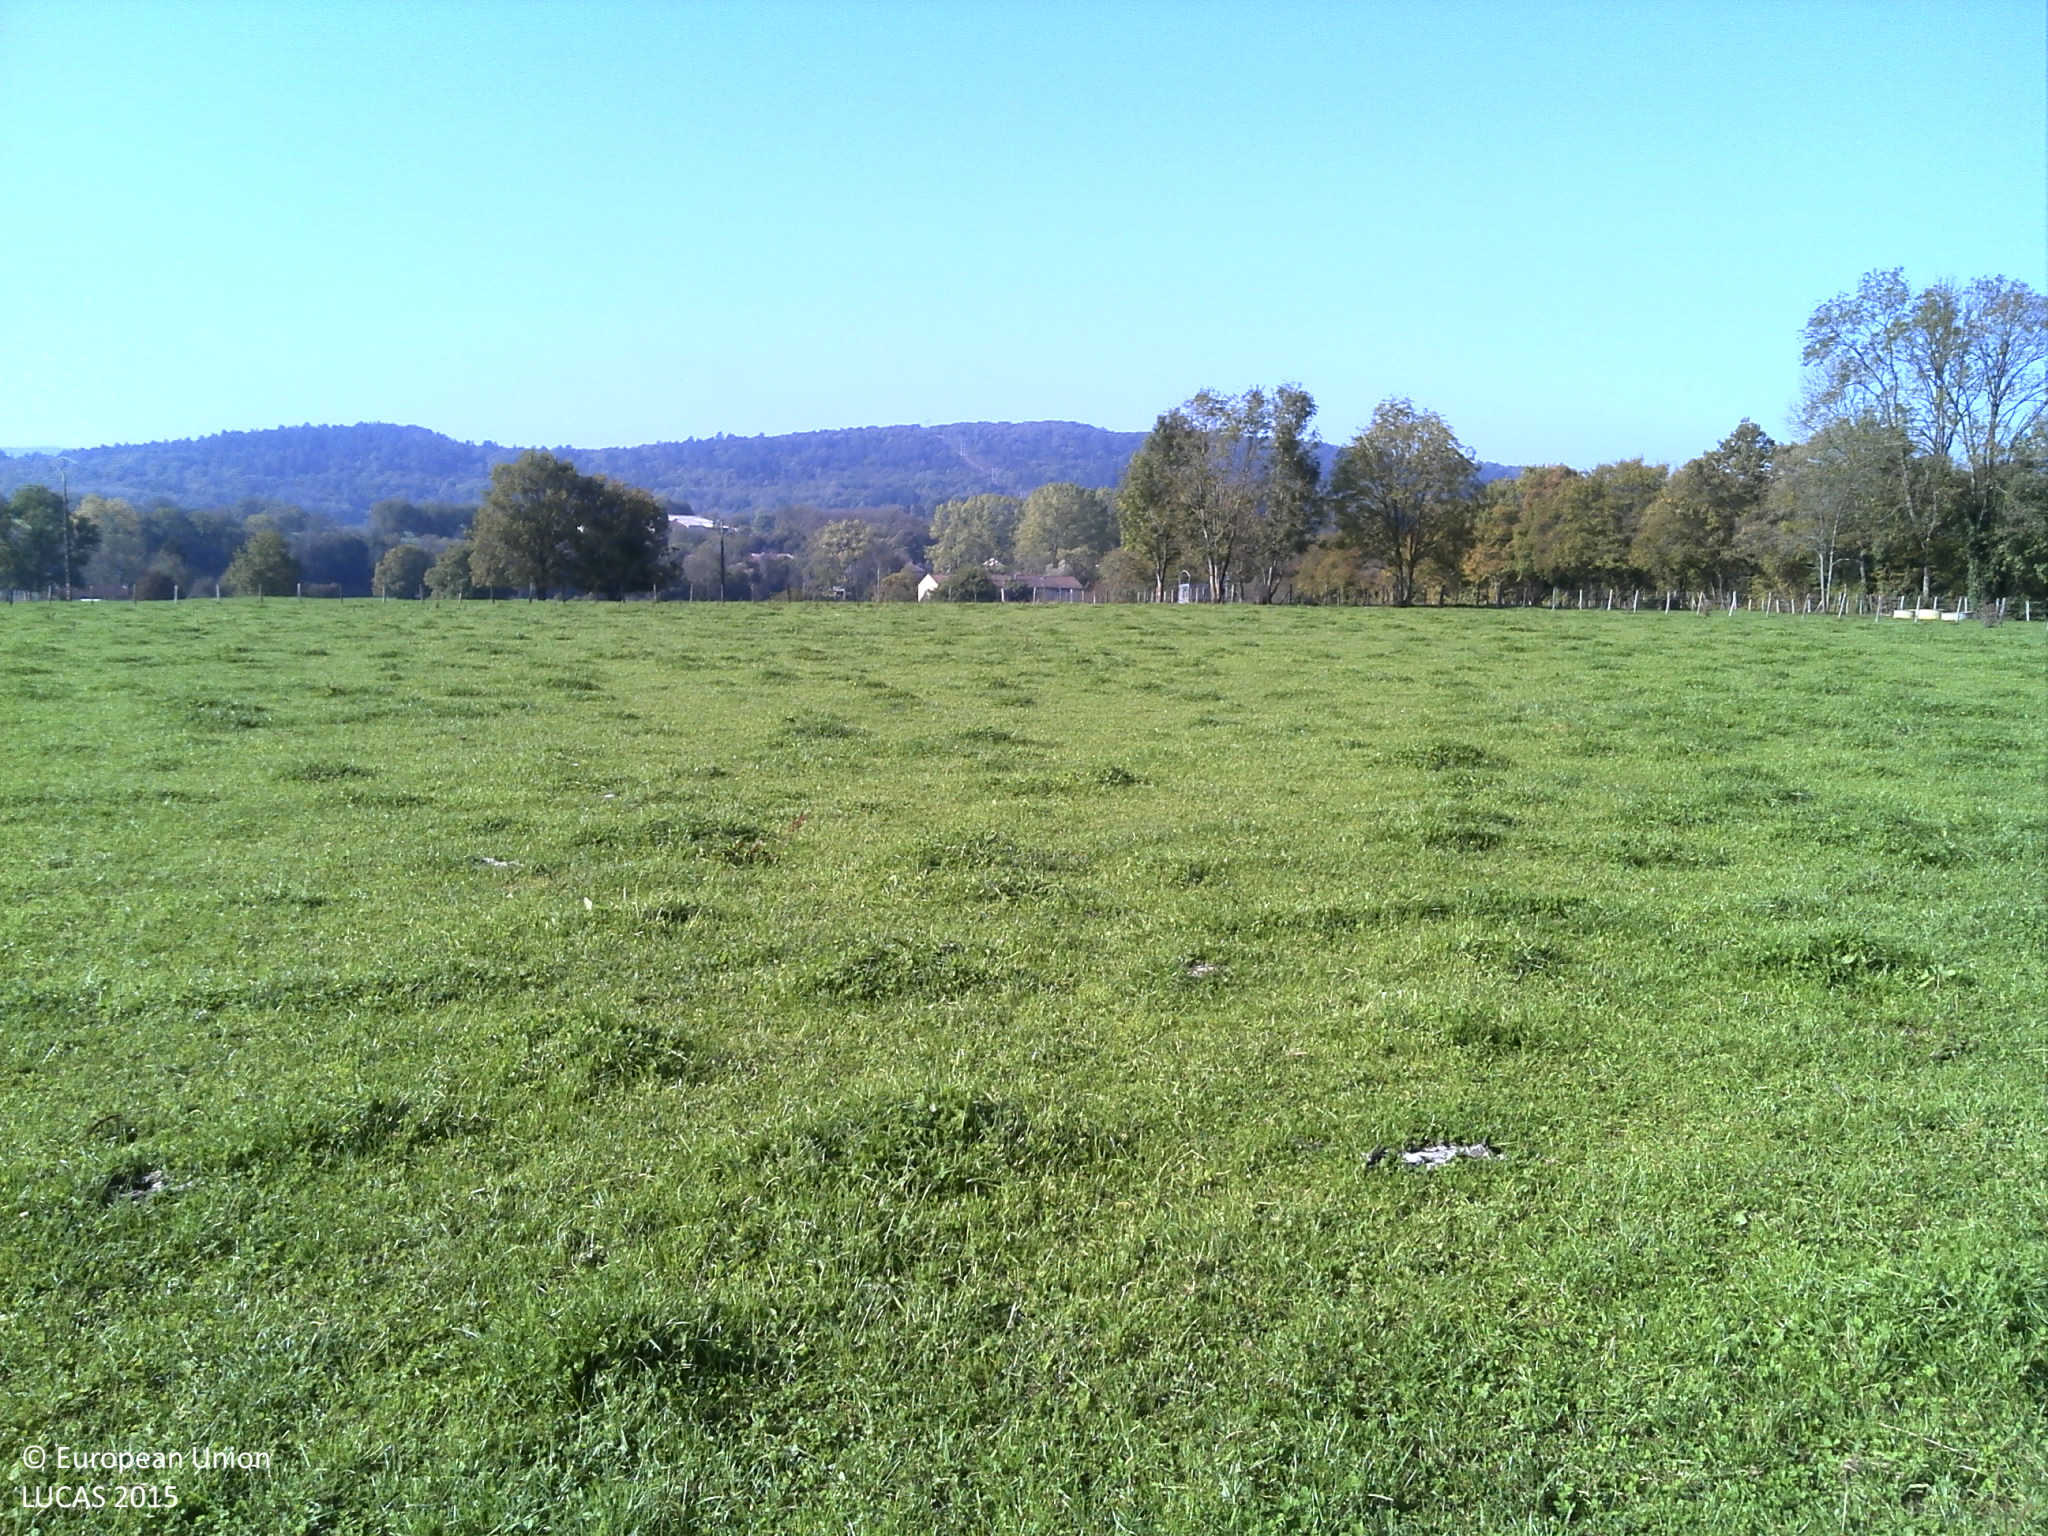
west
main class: Grassland
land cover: Grassland without tree/shrub cover
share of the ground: > 75 %
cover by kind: herbaceous plants 100 %
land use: Agriculture (excluding fallow land and kitchen gardens)
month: October
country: FR
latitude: 46.1983
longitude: 5.4028
